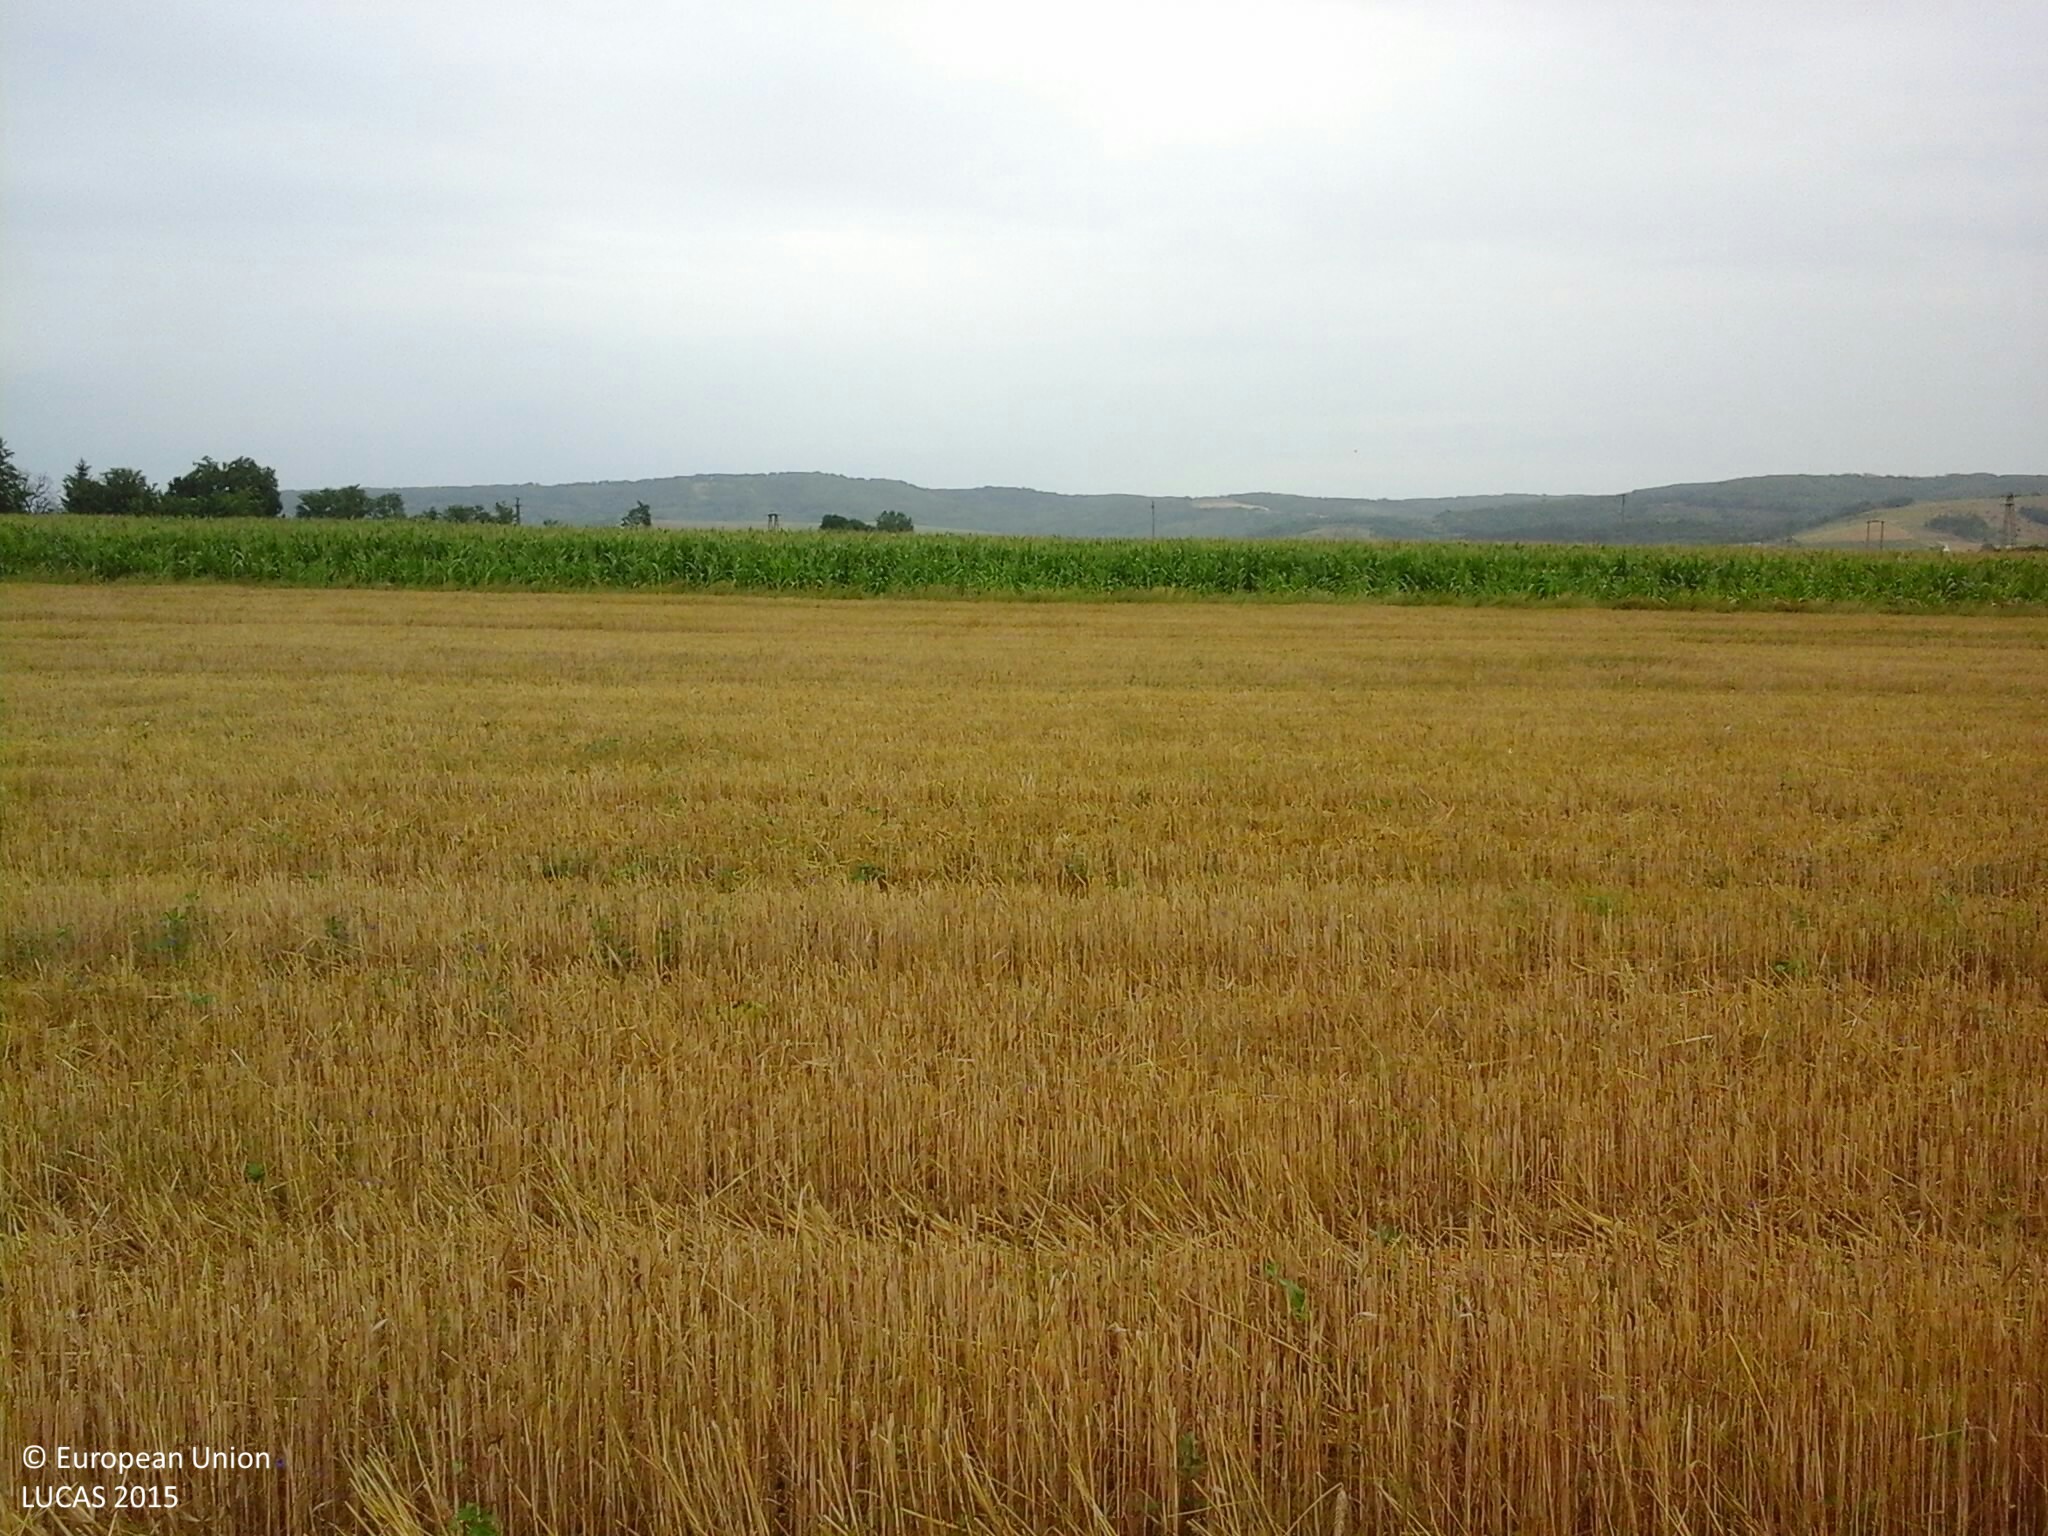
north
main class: Cropland
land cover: Barley
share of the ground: 25 - 50 %
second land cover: Spontaneously vegetated surfaces
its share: < 10 %
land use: Agriculture (excluding fallow land and kitchen gardens)
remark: Harvested field
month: July
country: HU
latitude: 47.9696
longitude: 19.3581
